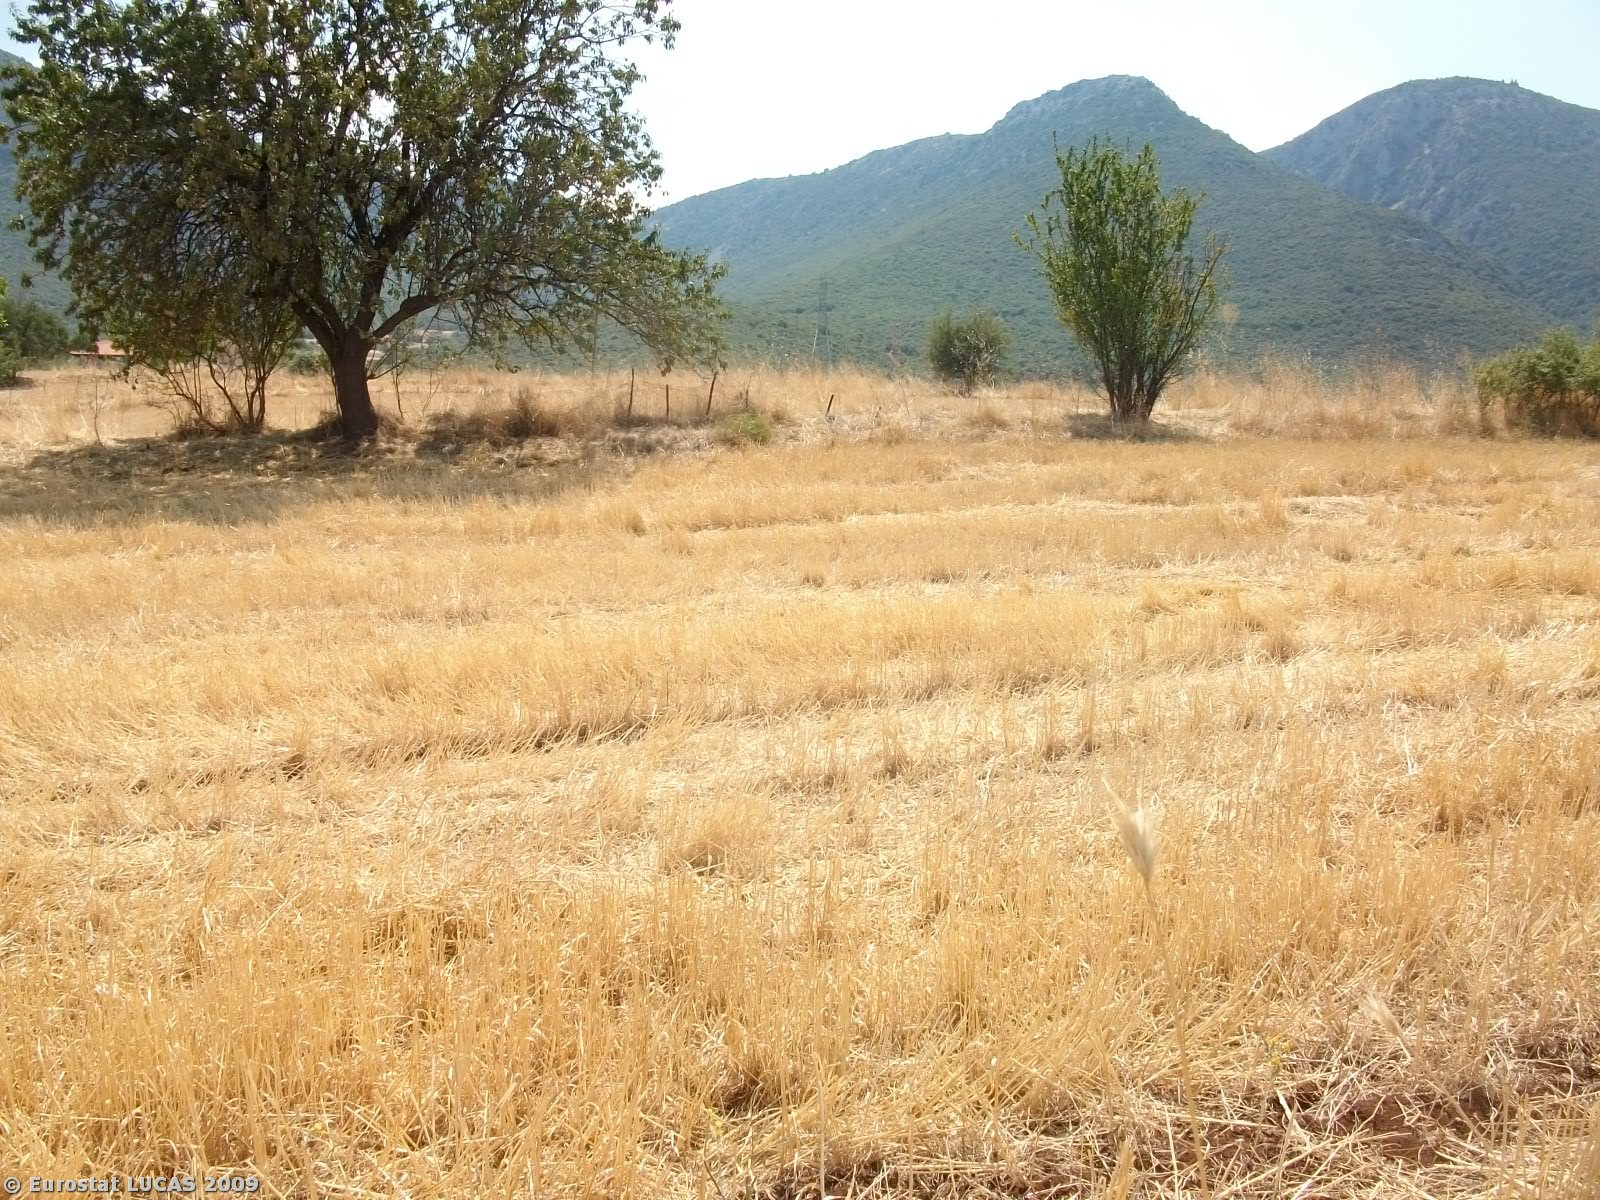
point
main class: Cropland
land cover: Durum wheat
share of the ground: < 10 %
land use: Agriculture (excluding fallow land and kitchen gardens)
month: August
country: GR
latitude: 38.7288
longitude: 22.6682
